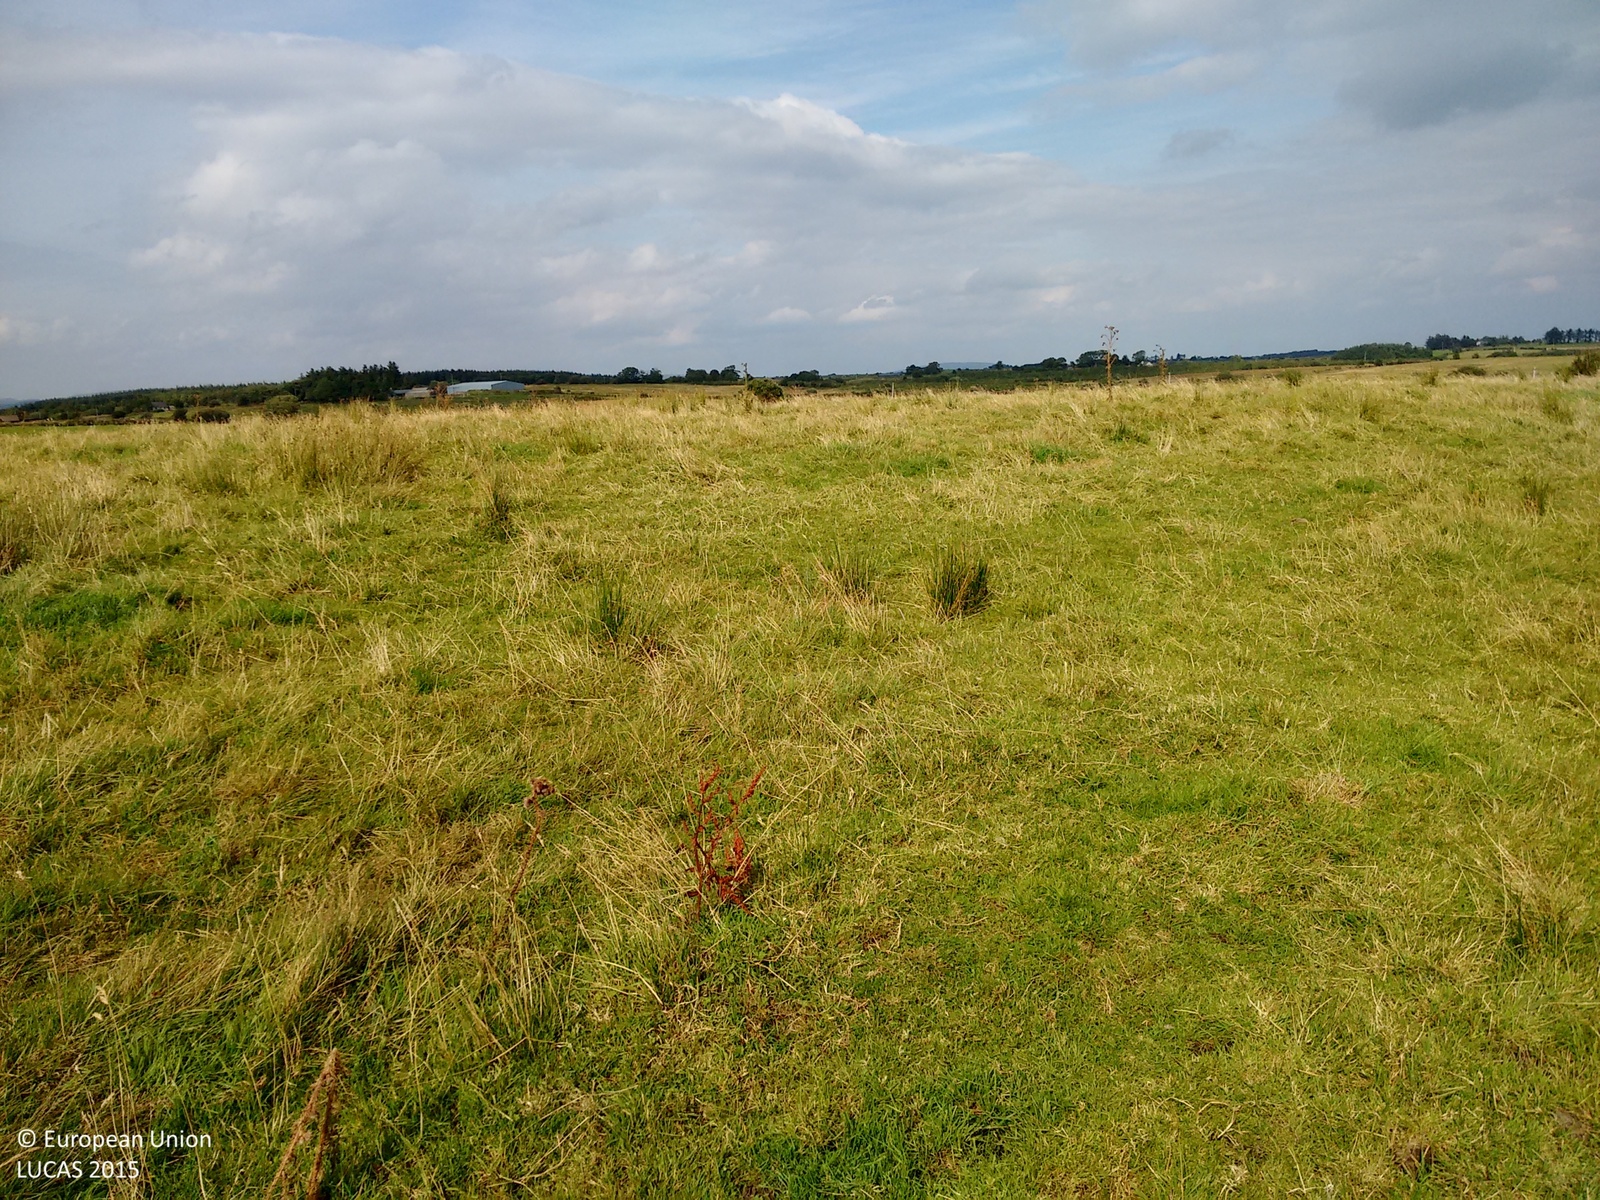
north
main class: Grassland
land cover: Grassland without tree/shrub cover
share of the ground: > 75 %
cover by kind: herbaceous plants 100 %
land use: Agriculture (excluding fallow land and kitchen gardens)
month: September
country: IE
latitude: 54.1097
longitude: -9.3929
